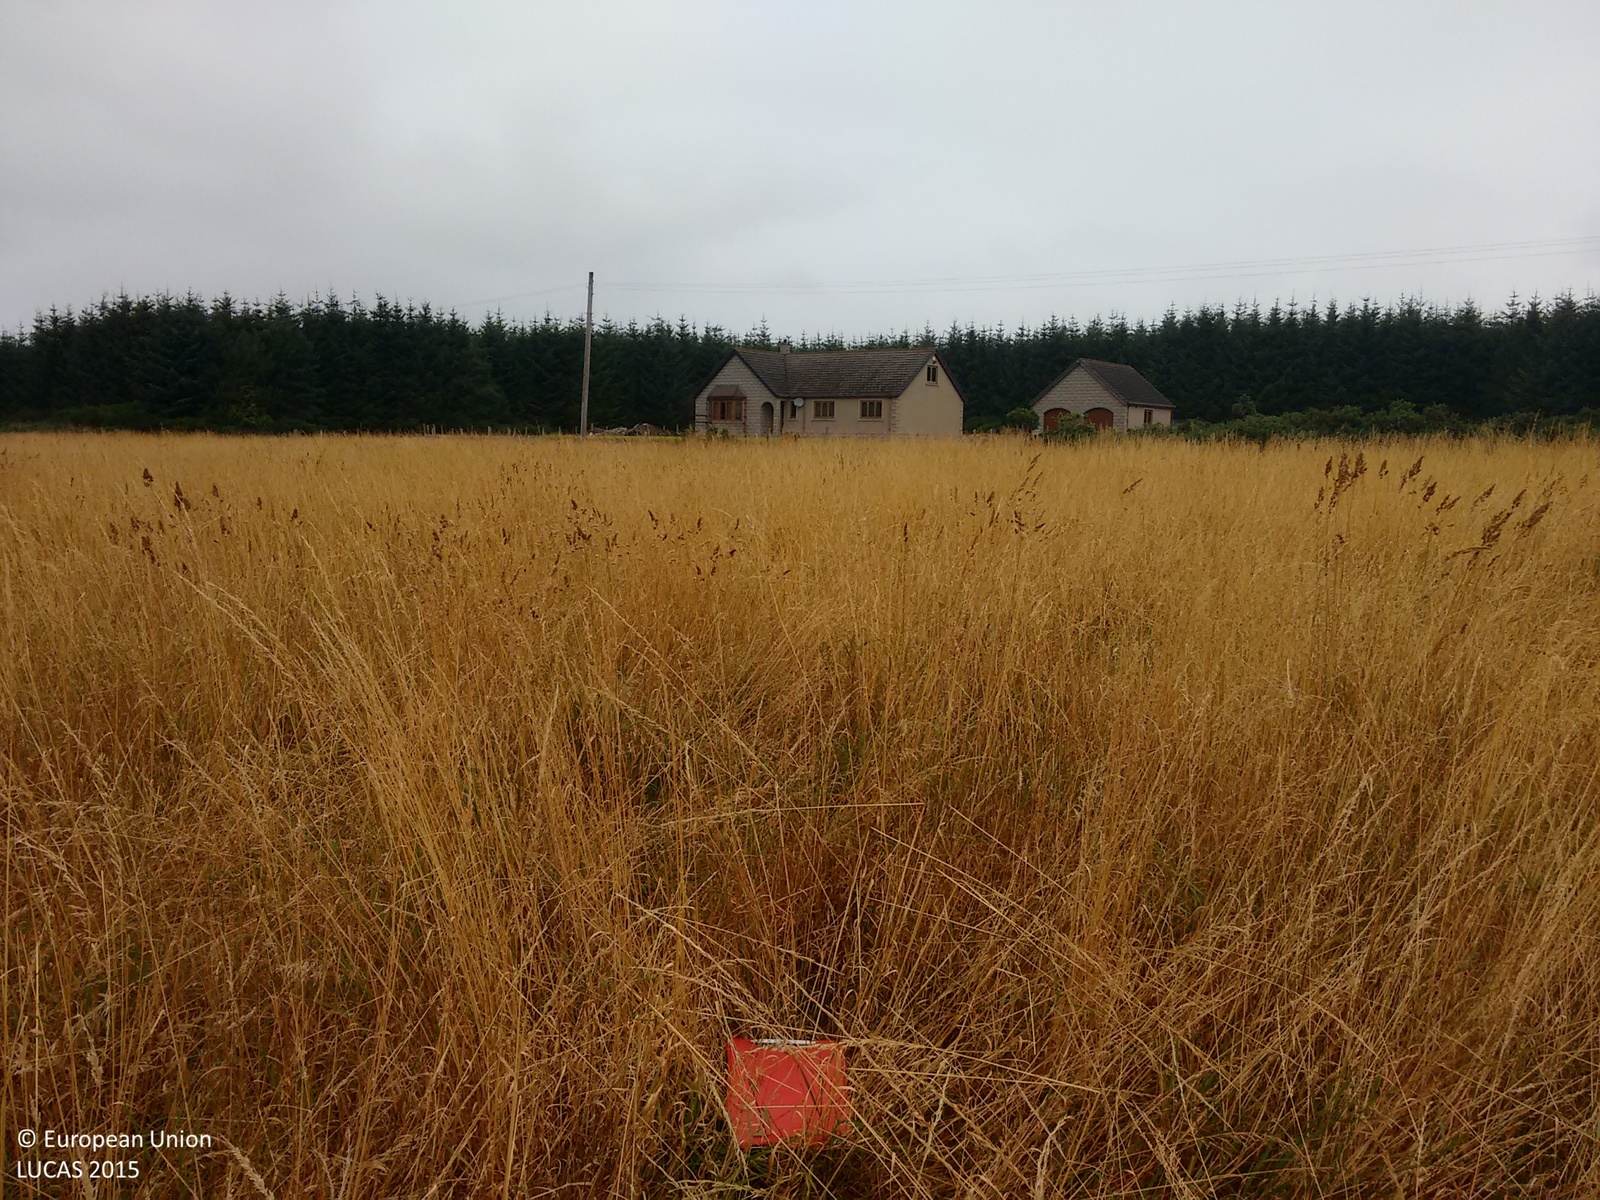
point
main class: Grassland
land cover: Grassland without tree/shrub cover
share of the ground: > 75 %
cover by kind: herbaceous plants 100 %
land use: Agriculture (excluding fallow land and kitchen gardens)
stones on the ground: 10 - 25 %
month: September
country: GB
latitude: 57.6867
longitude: -2.8896
